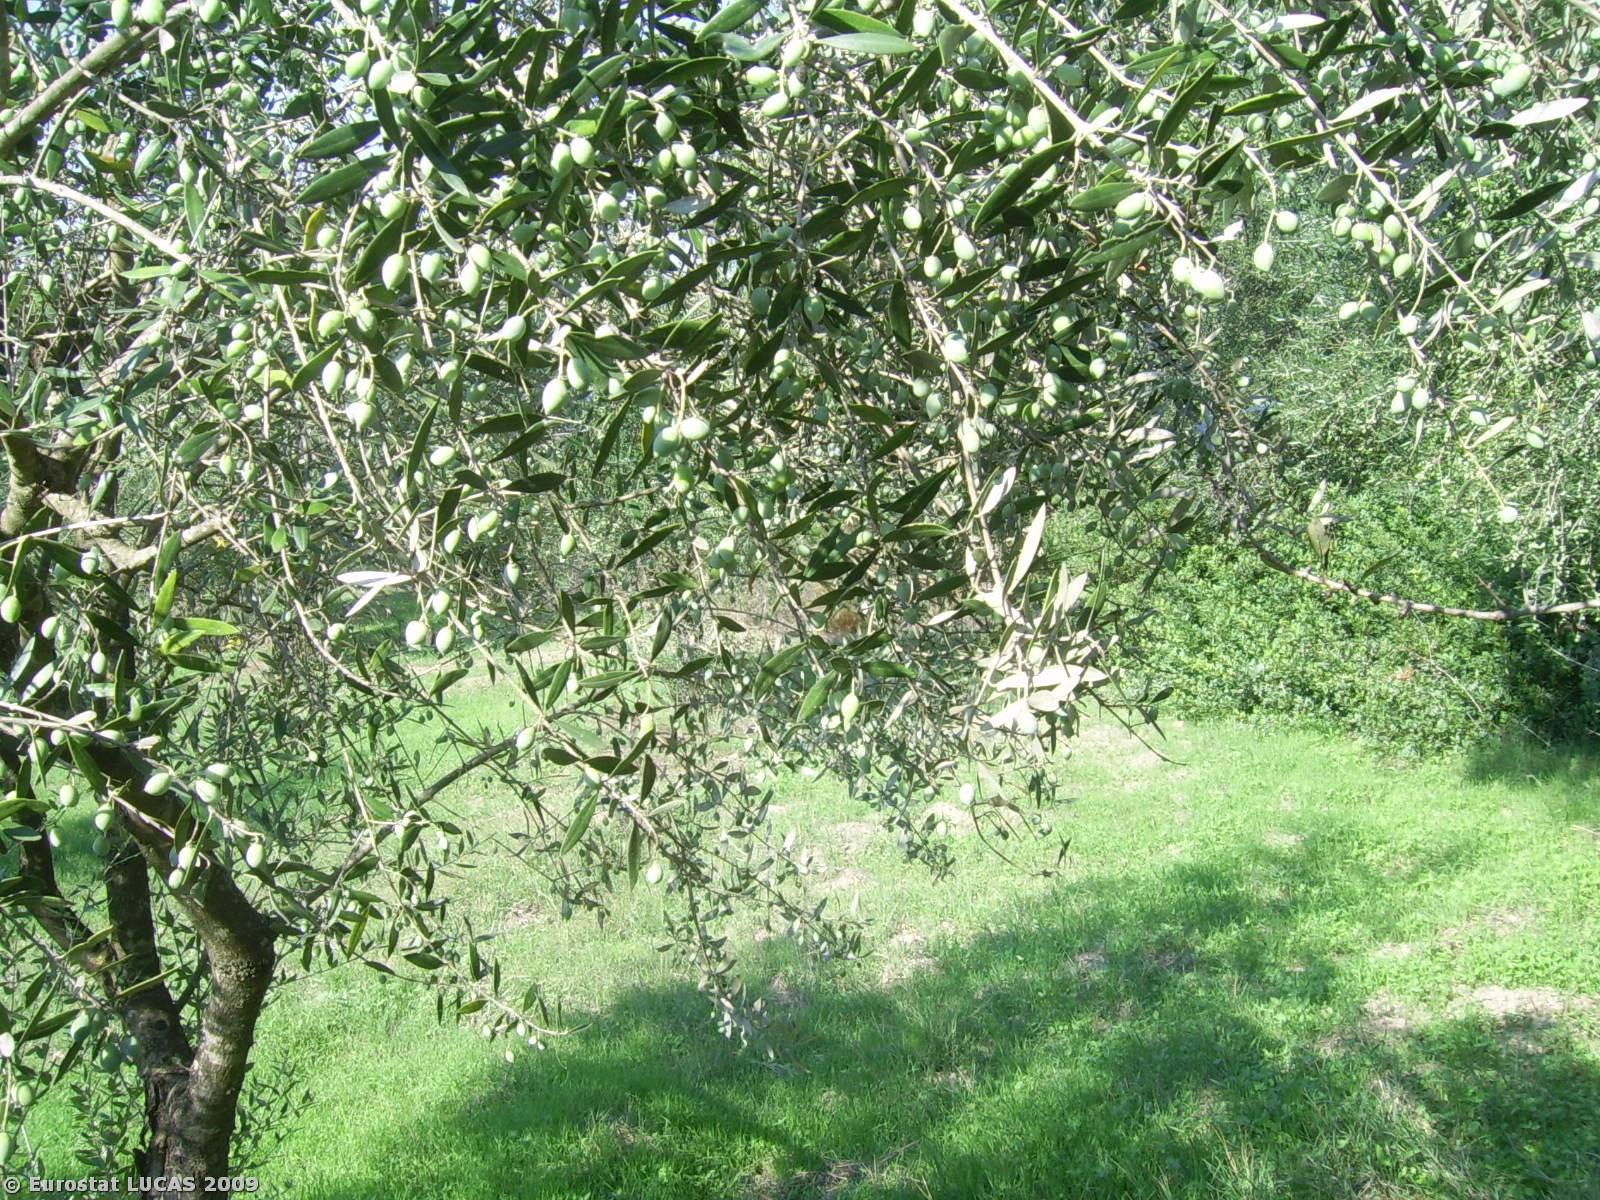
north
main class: Shrubland
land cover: Shrubland with sparse tree cover
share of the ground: > 75 %
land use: Unused
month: October
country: GR
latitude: 37.8279
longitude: 21.4014
